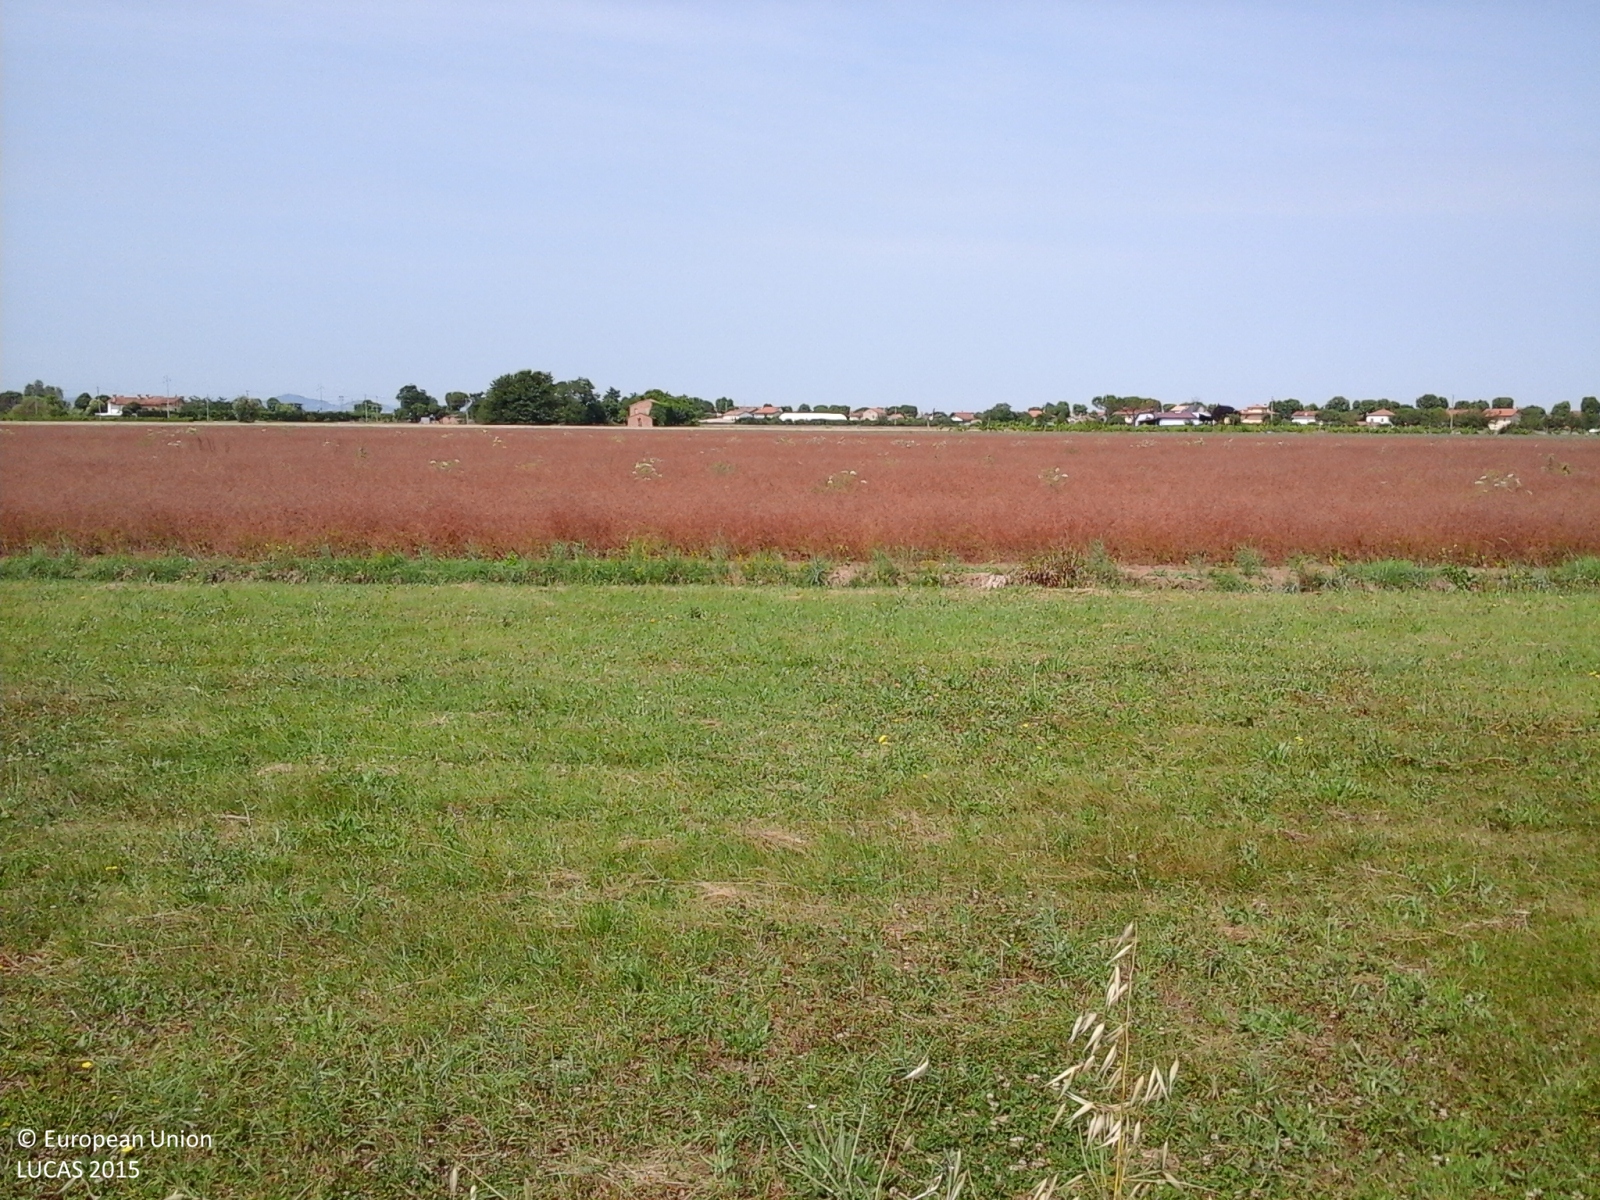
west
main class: Cropland
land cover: Vineyards
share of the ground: > 75 %
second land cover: Grassland without tree/shrub cover
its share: > 75 %
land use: Agriculture (excluding fallow land and kitchen gardens)
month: June
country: IT
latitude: 44.1974
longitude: 12.3596
